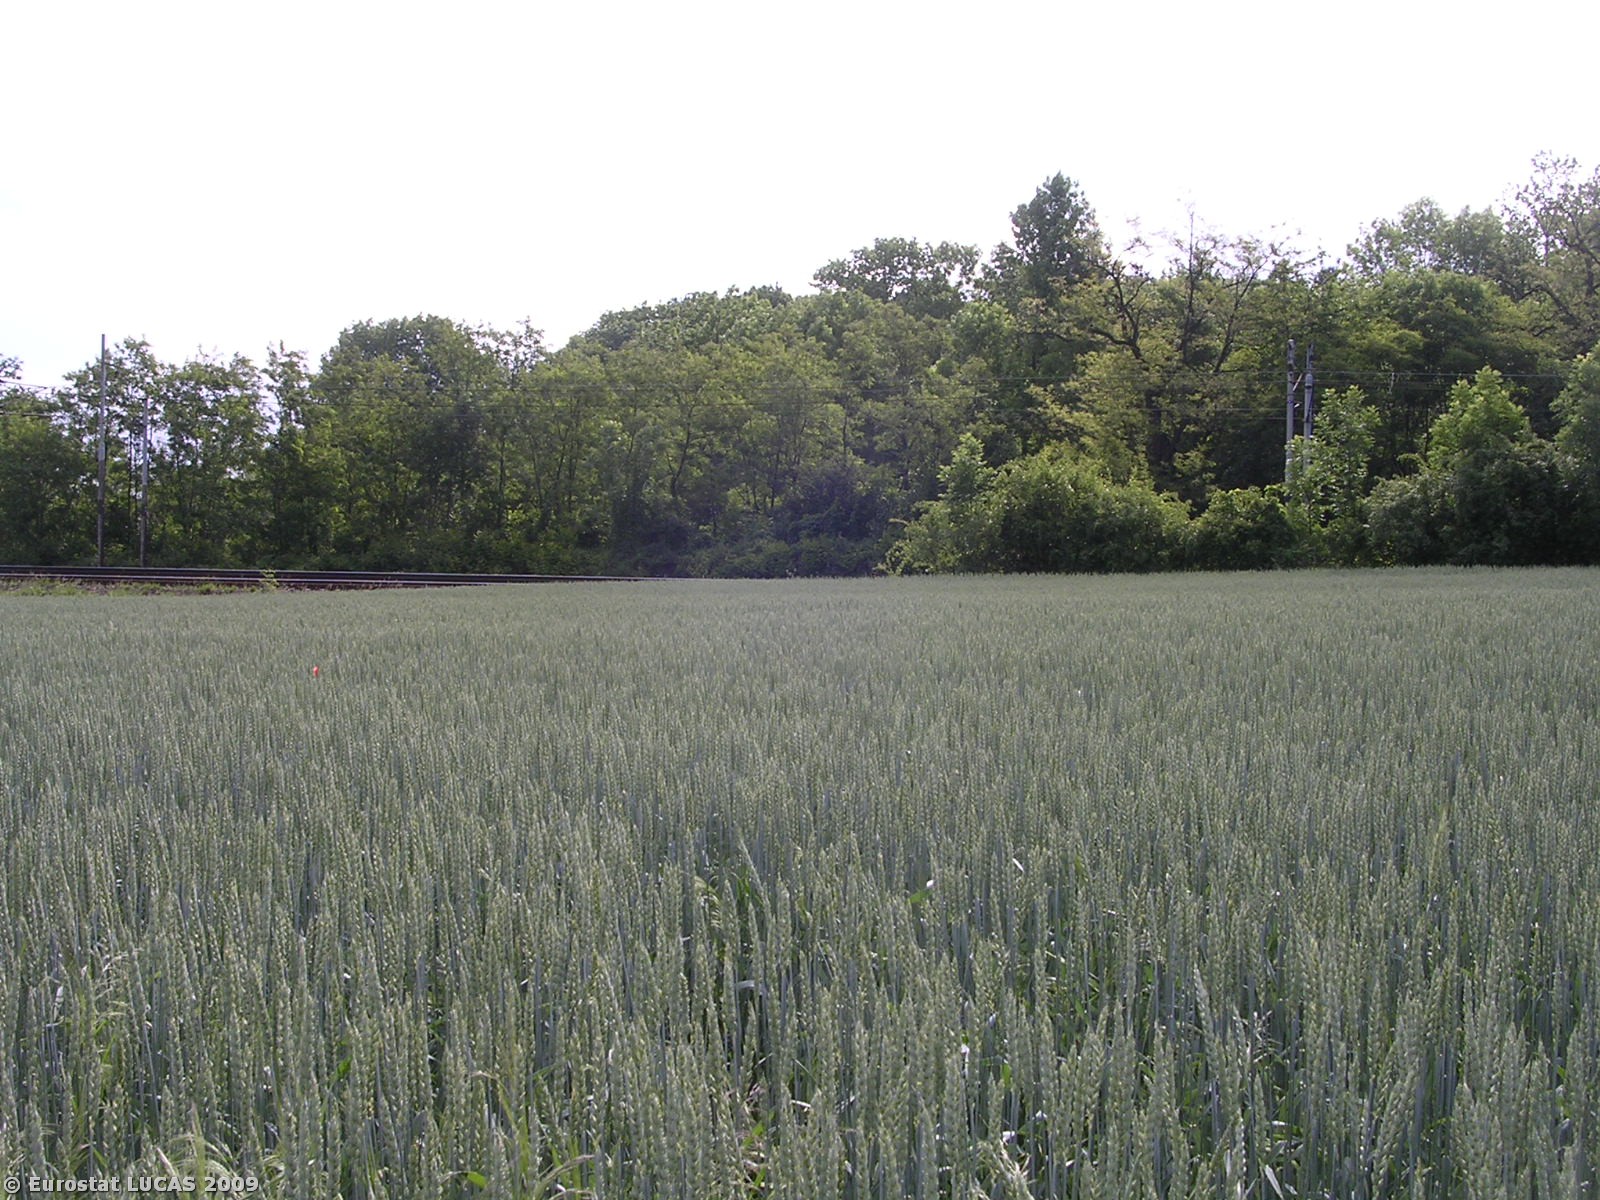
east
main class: Cropland
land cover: Common wheat
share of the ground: > 75 %
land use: Agriculture (excluding fallow land and kitchen gardens)
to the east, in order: Common wheat; Grass margins; Tracks; Grass margins; Railways; Ditches and canals; Groves; Broadleaved woodland; Grassland without tree/shrub cover; Broadleaved woodland; Mixed woodland
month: June
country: CZ
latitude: 50.4993
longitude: 14.3014
